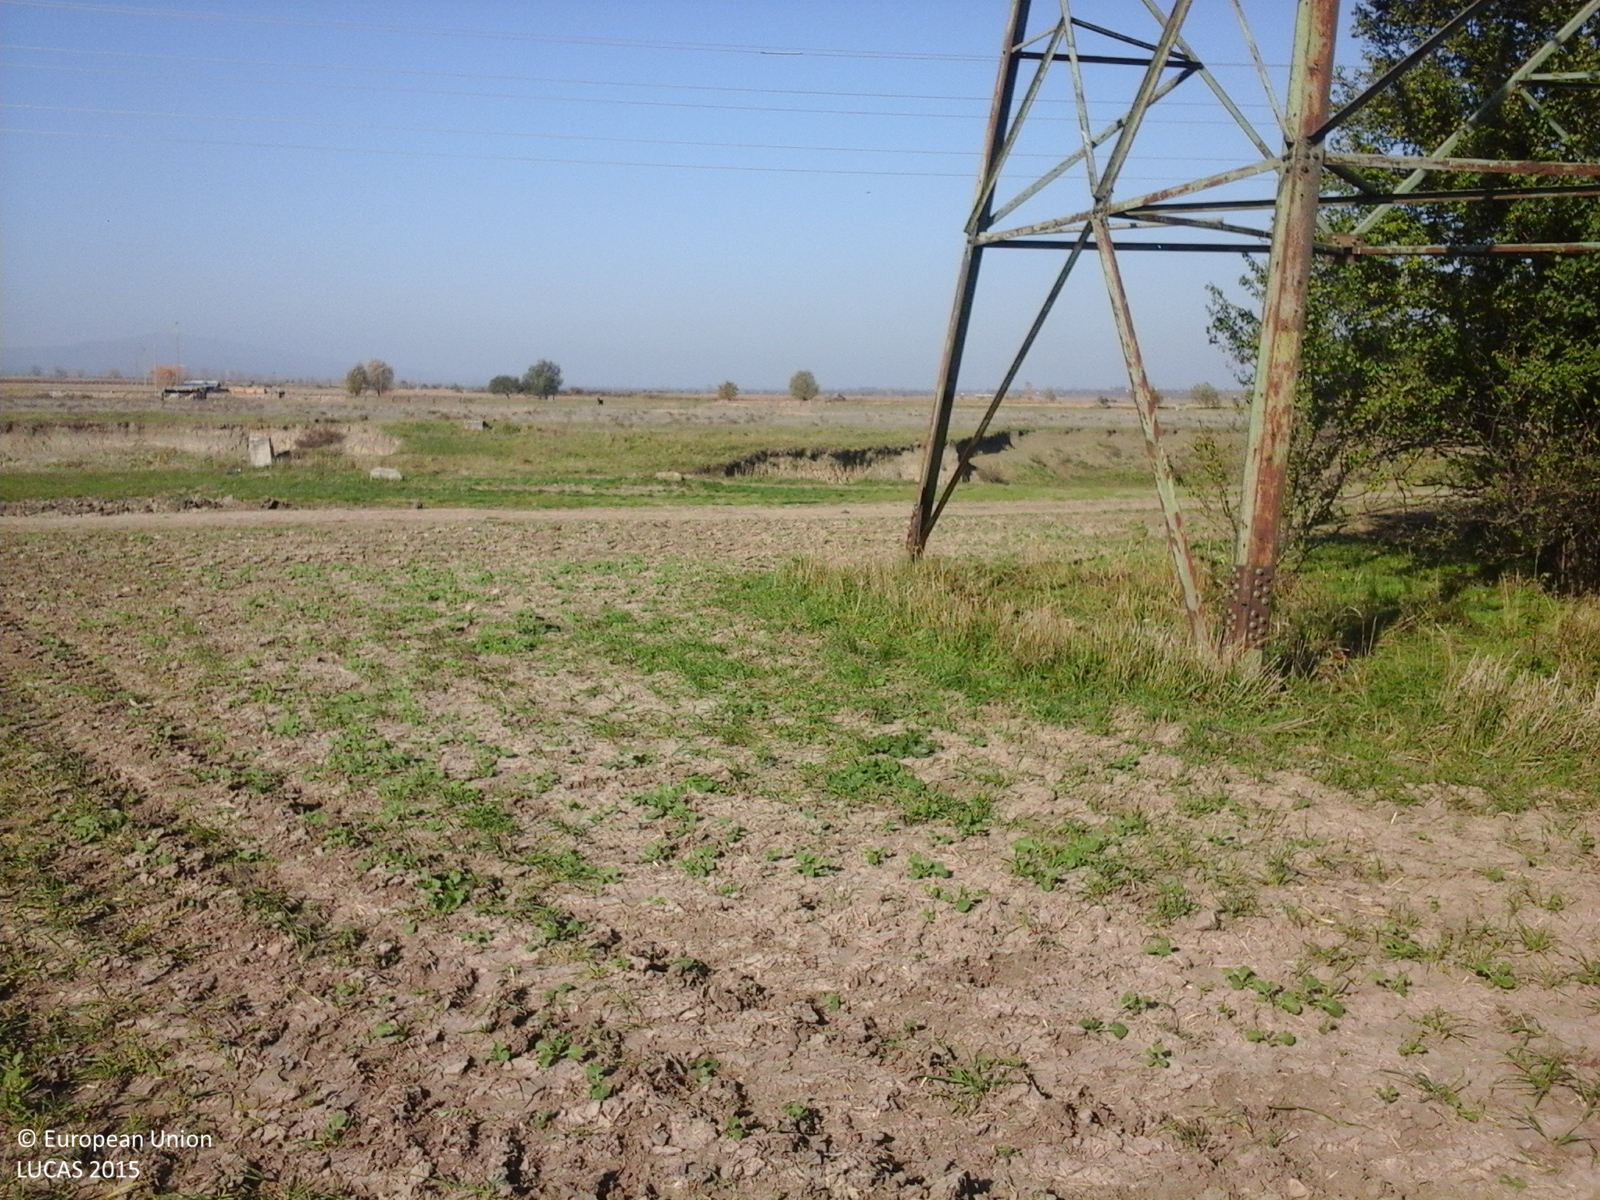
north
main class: Cropland
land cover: Rape and turnip rape
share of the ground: 50 - 75 %
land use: Agriculture (excluding fallow land and kitchen gardens)
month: October
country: RO
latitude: 45.6739
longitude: 27.1280
